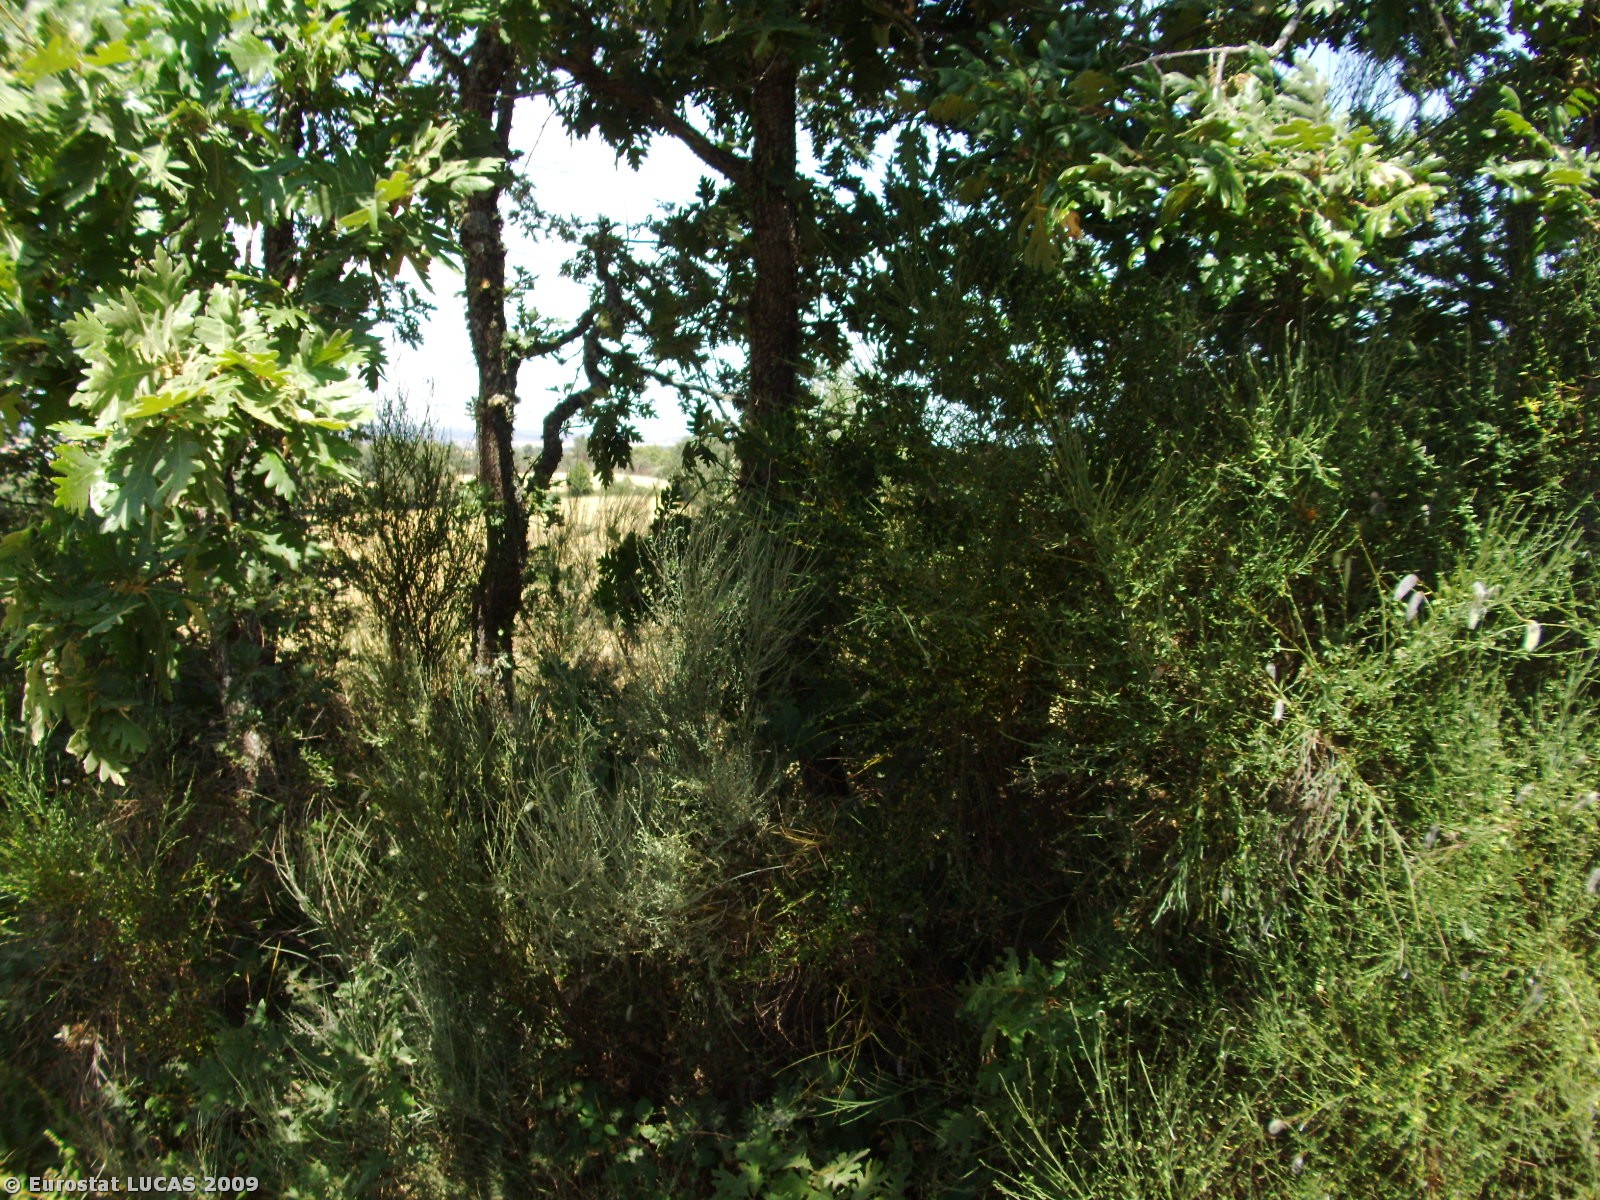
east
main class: Grassland
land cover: Spontaneously vegetated surfaces
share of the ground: > 75 %
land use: Fallow land
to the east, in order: Spontaneously vegetated surfaces; Broadleaved woodland; Rye; Fences; Tracks; Broadleaved woodland; Nuts trees; Rye
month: July
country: PT
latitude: 40.3446
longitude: -6.9657
